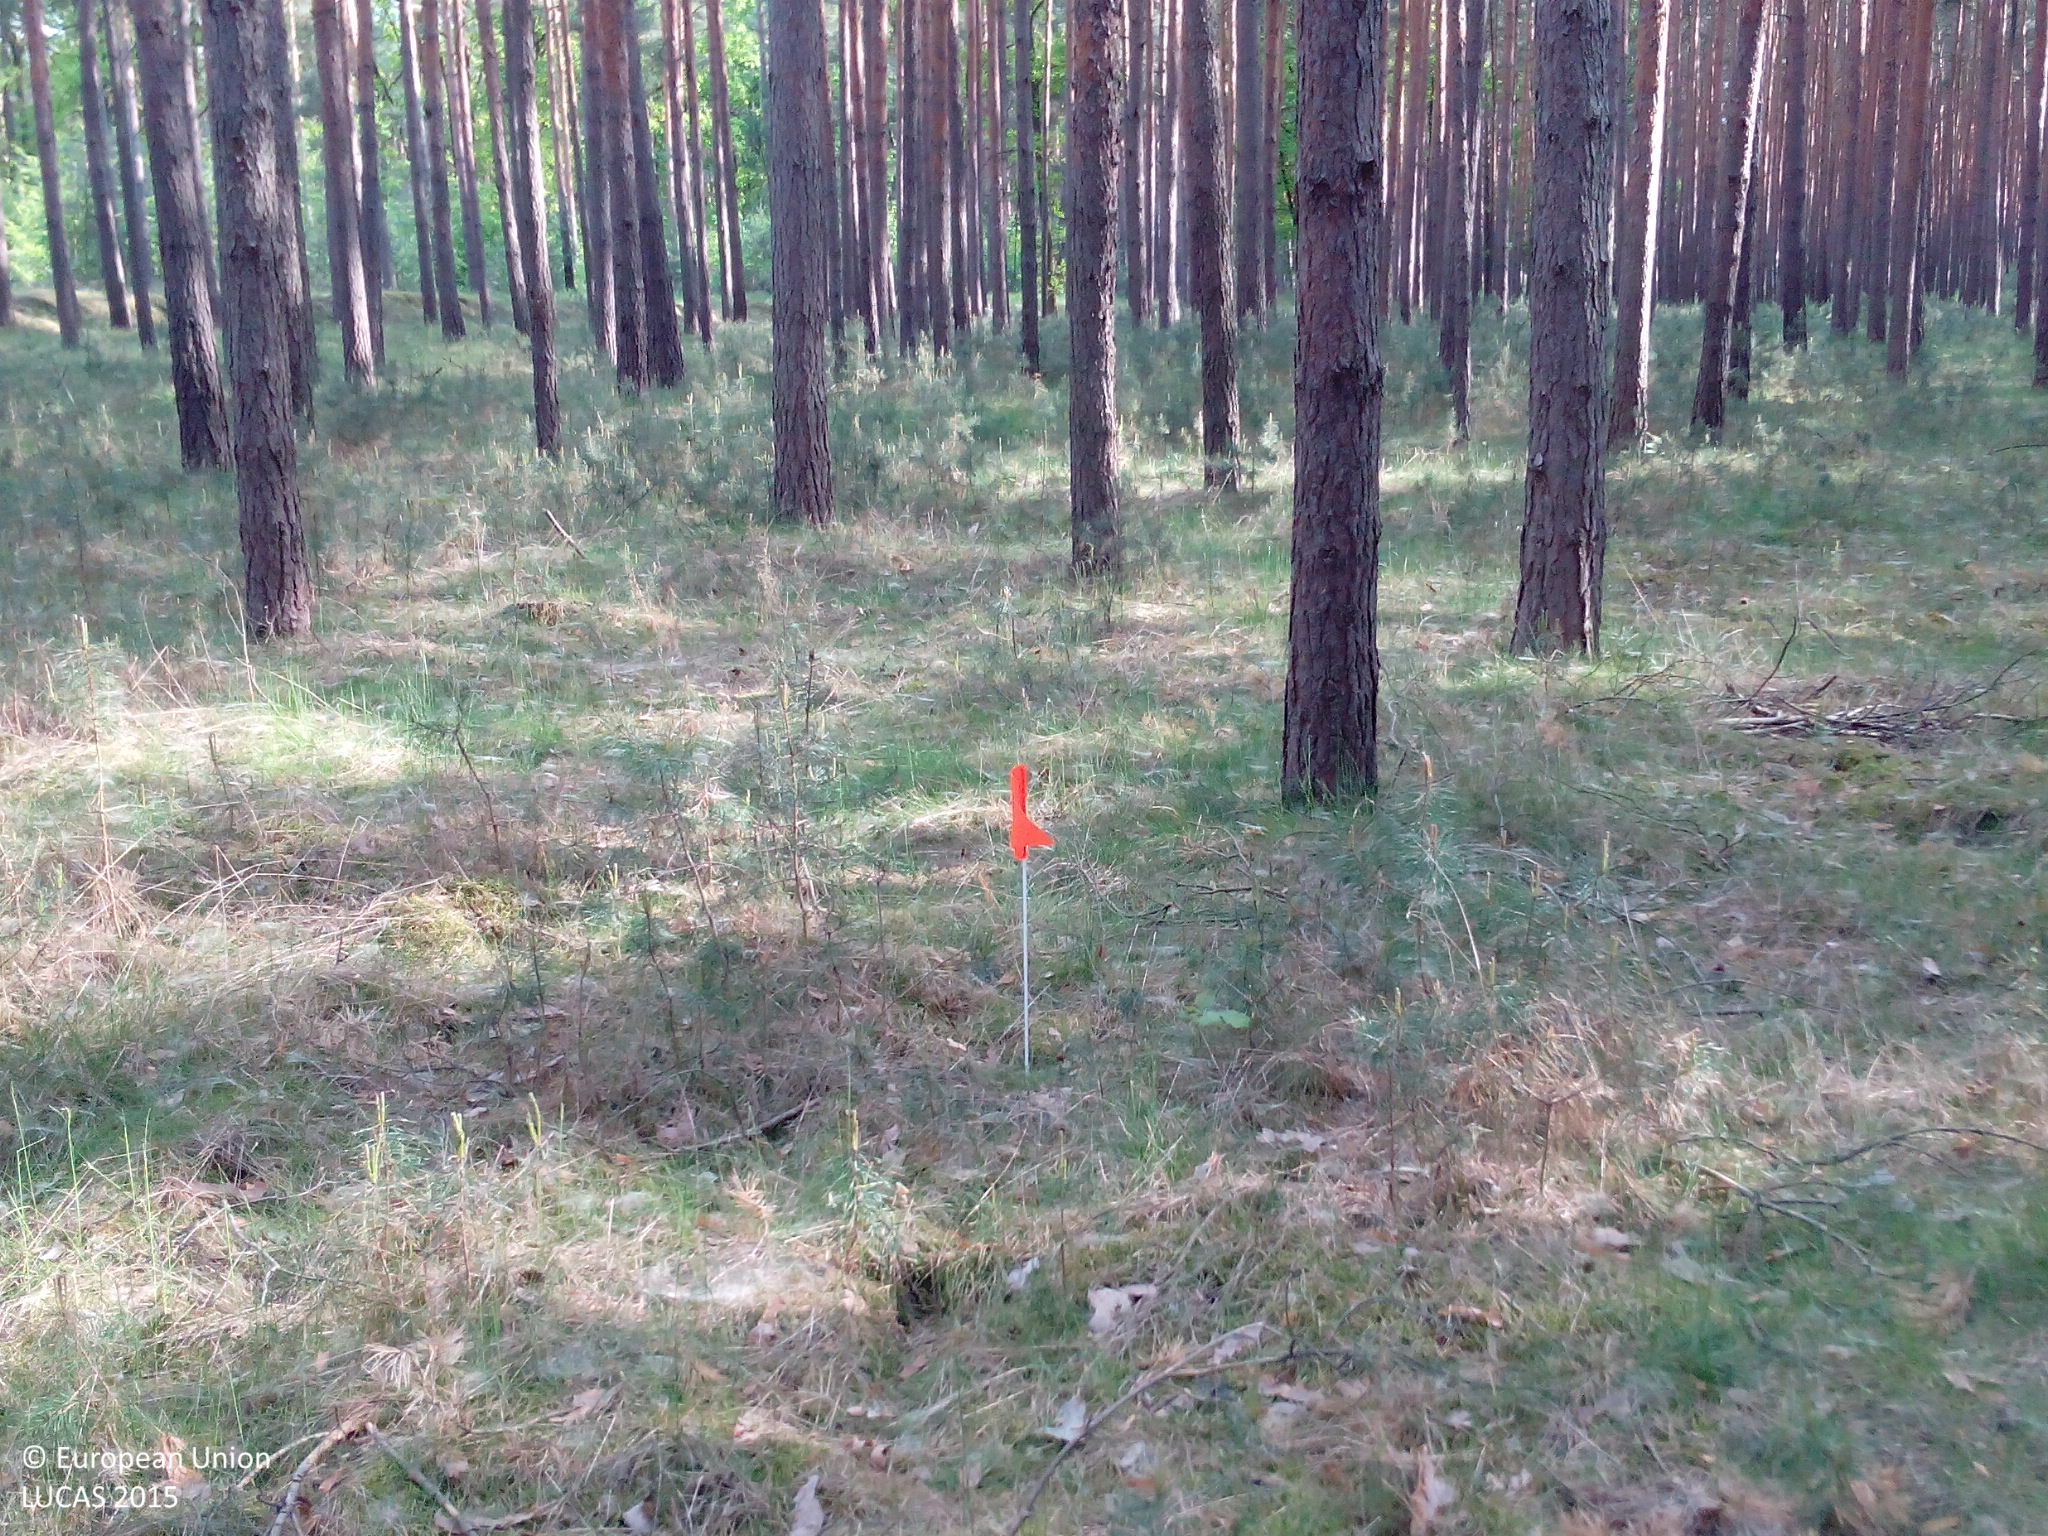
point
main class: Woodland
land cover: Pine dominated coniferous woodland
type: hemiboreal forest and nemoral coniferous forest and mixed broadleaved-coniferous forest
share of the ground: > 75 %
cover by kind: coniferous forest trees 75 %, herbaceous plants 15 %, lichens and mosses 10 %
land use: Forestry
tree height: > 5 m
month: May
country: DE
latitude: 52.1560
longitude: 13.1426
